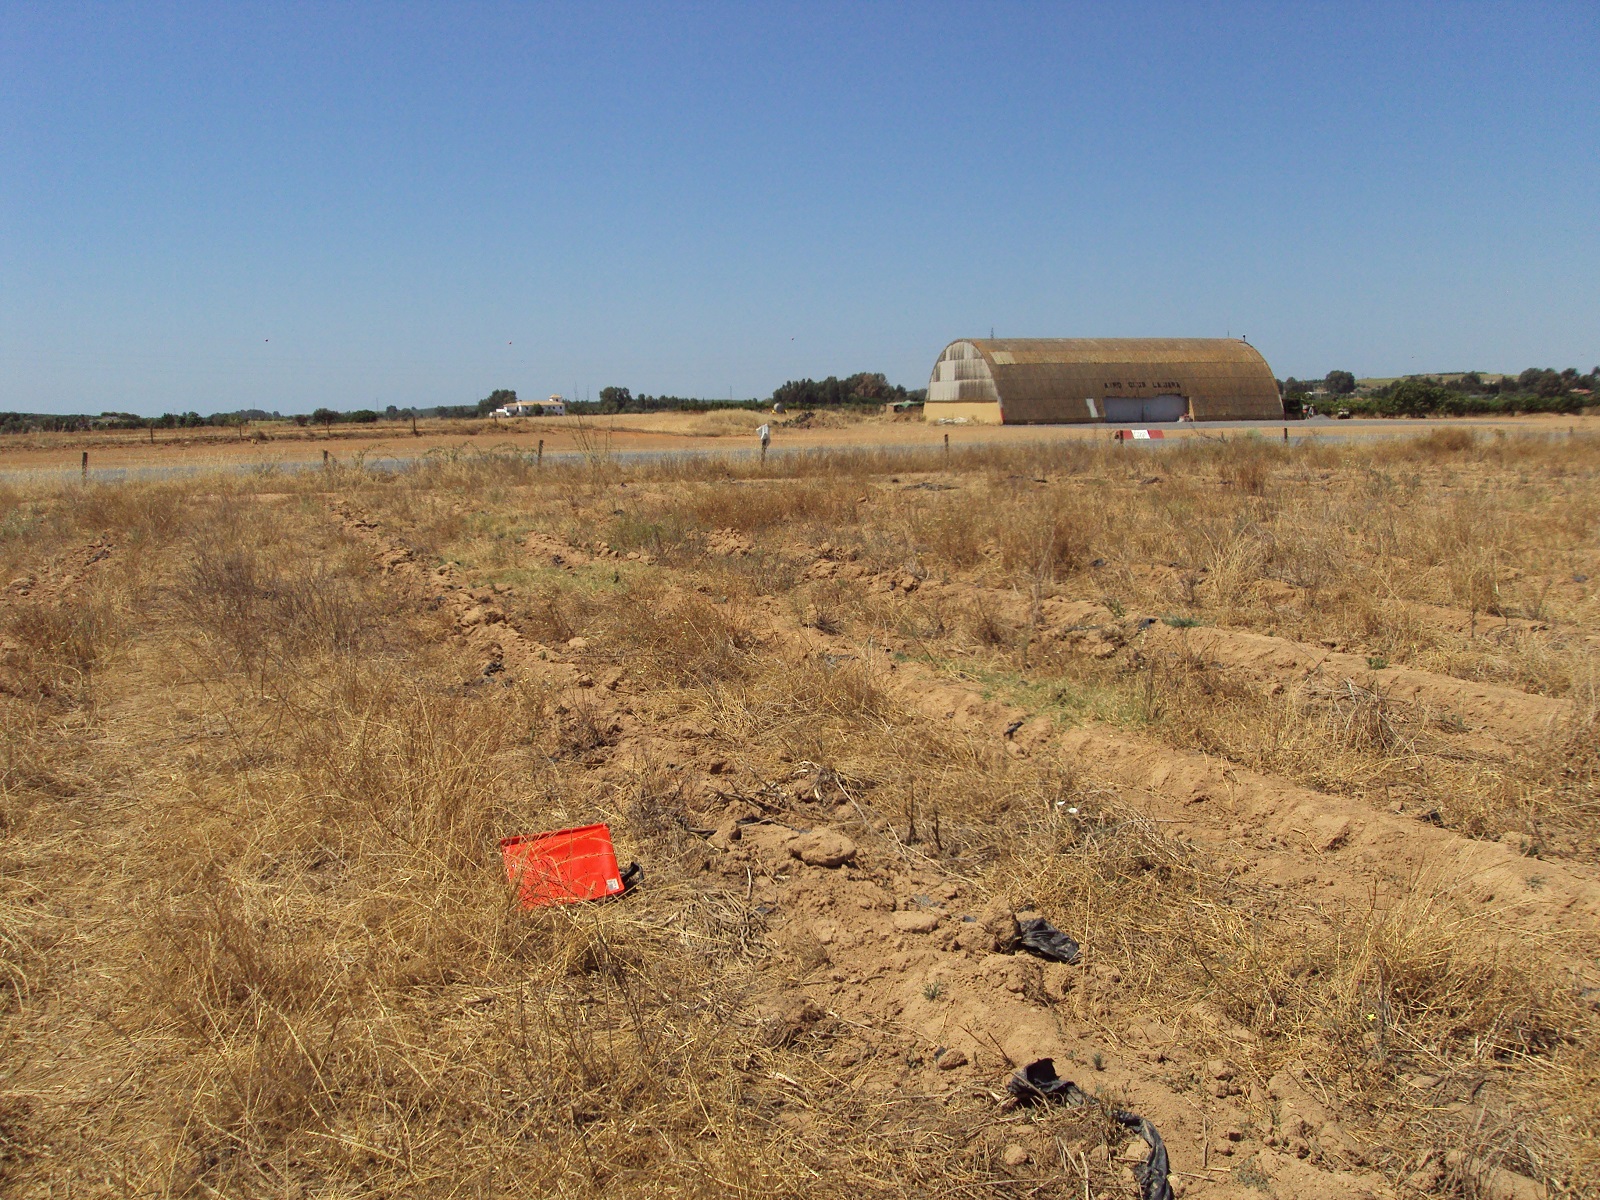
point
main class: Grassland
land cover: Grassland without tree/shrub cover
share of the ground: > 75 %
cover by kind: herbaceous plants 90 %, unconsolidated bare surface 10 %
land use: Agriculture (excluding fallow land and kitchen gardens)
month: June
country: ES
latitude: 37.3647
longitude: -6.9202
